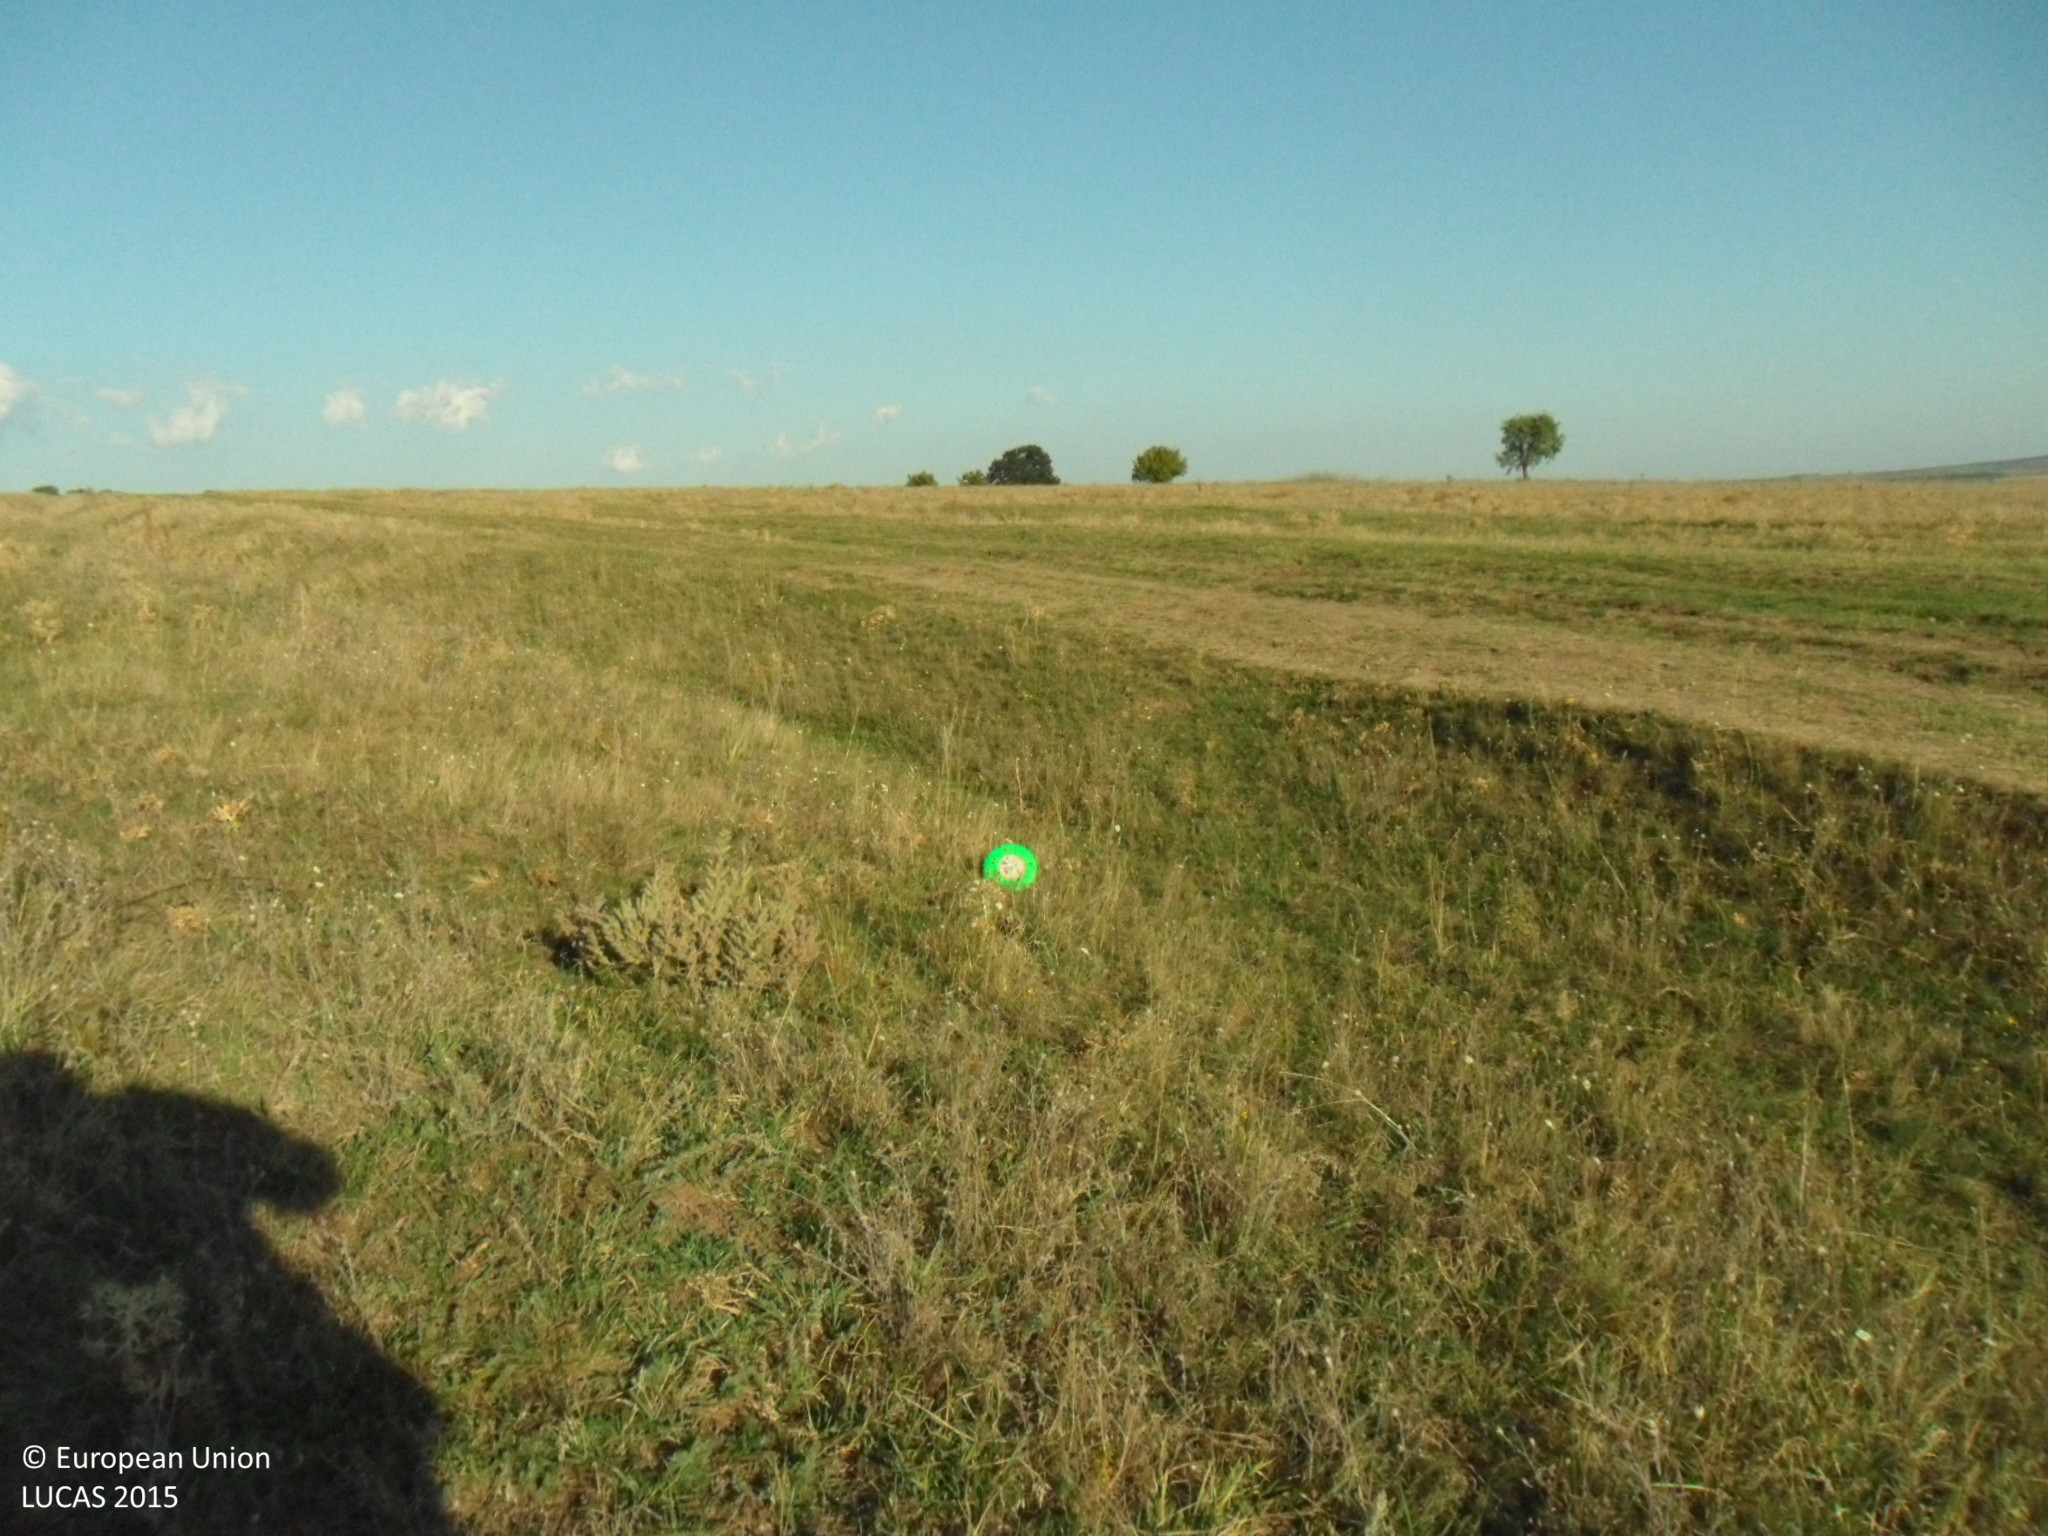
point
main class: Grassland
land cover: Grassland without tree/shrub cover
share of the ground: > 75 %
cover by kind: herbaceous plants 100 %
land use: Agriculture (excluding fallow land and kitchen gardens)
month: September
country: BG
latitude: 43.4513
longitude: 27.2130
